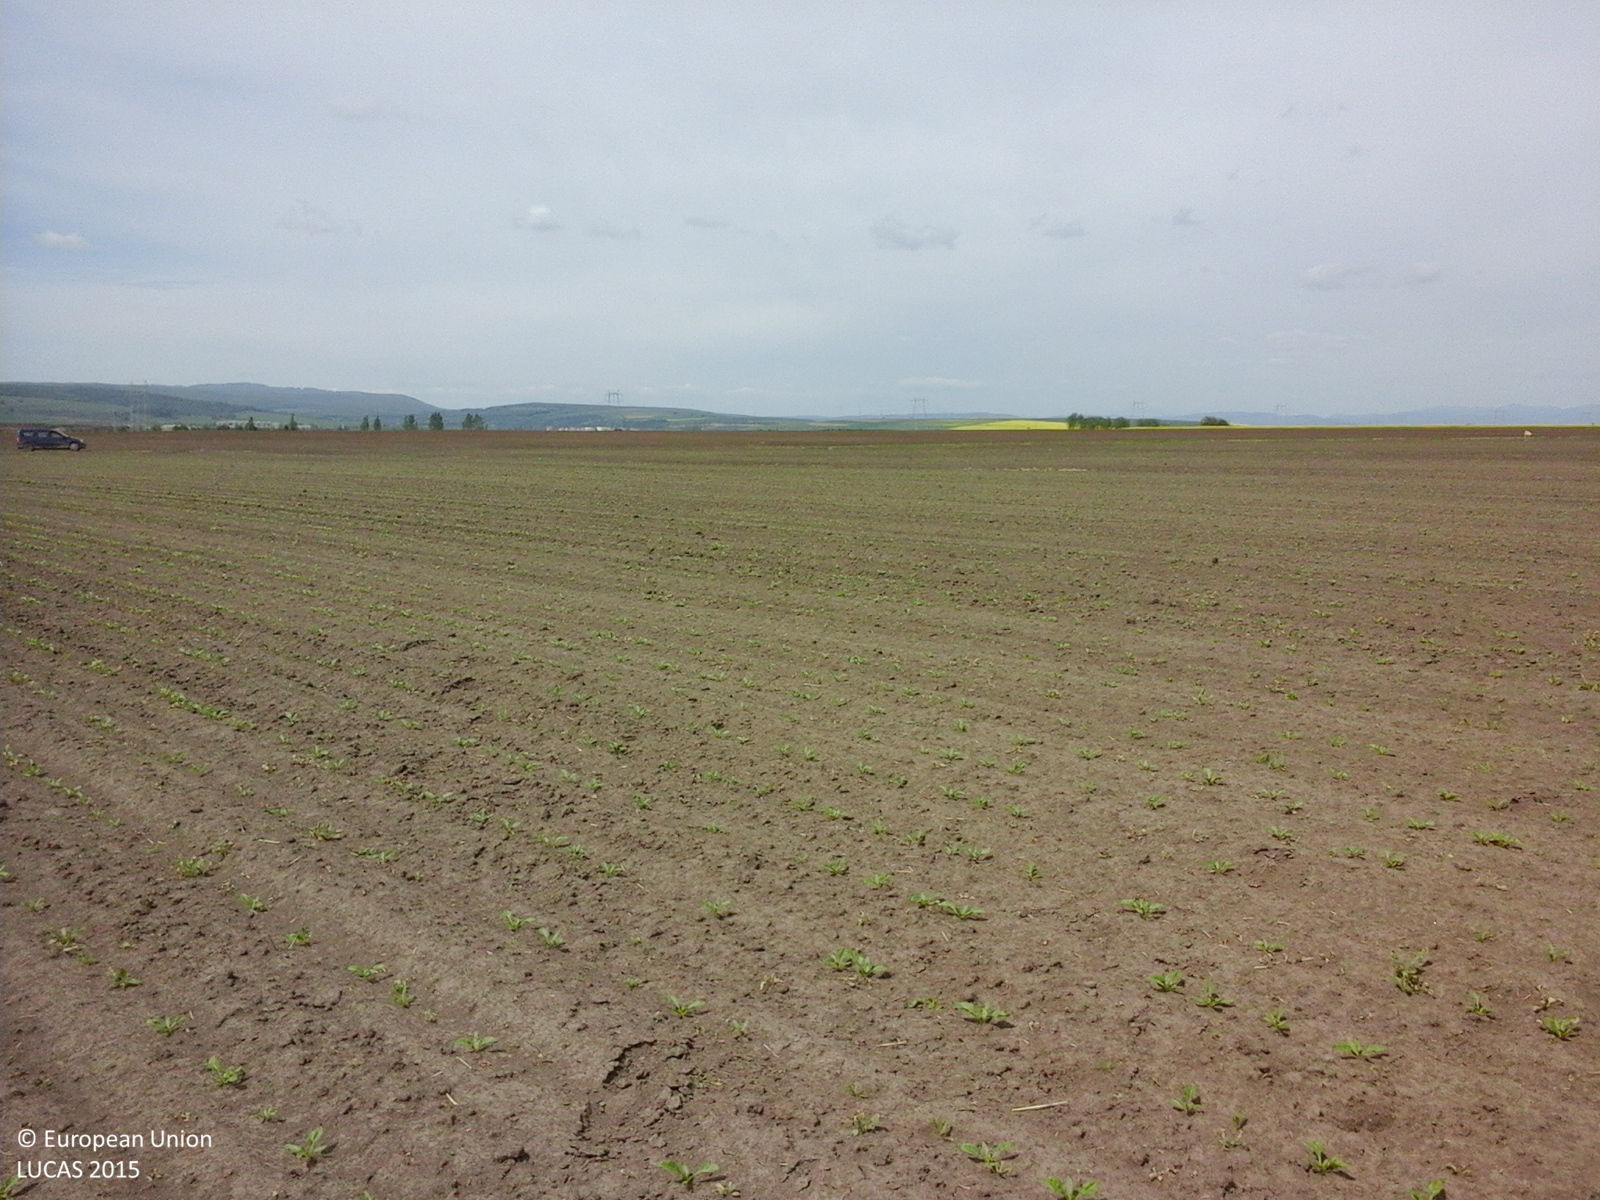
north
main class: Cropland
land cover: Sugar beet
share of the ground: < 10 %
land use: Agriculture (excluding fallow land and kitchen gardens)
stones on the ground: < 10 %
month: May
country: RO
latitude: 45.8532
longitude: 25.9948
